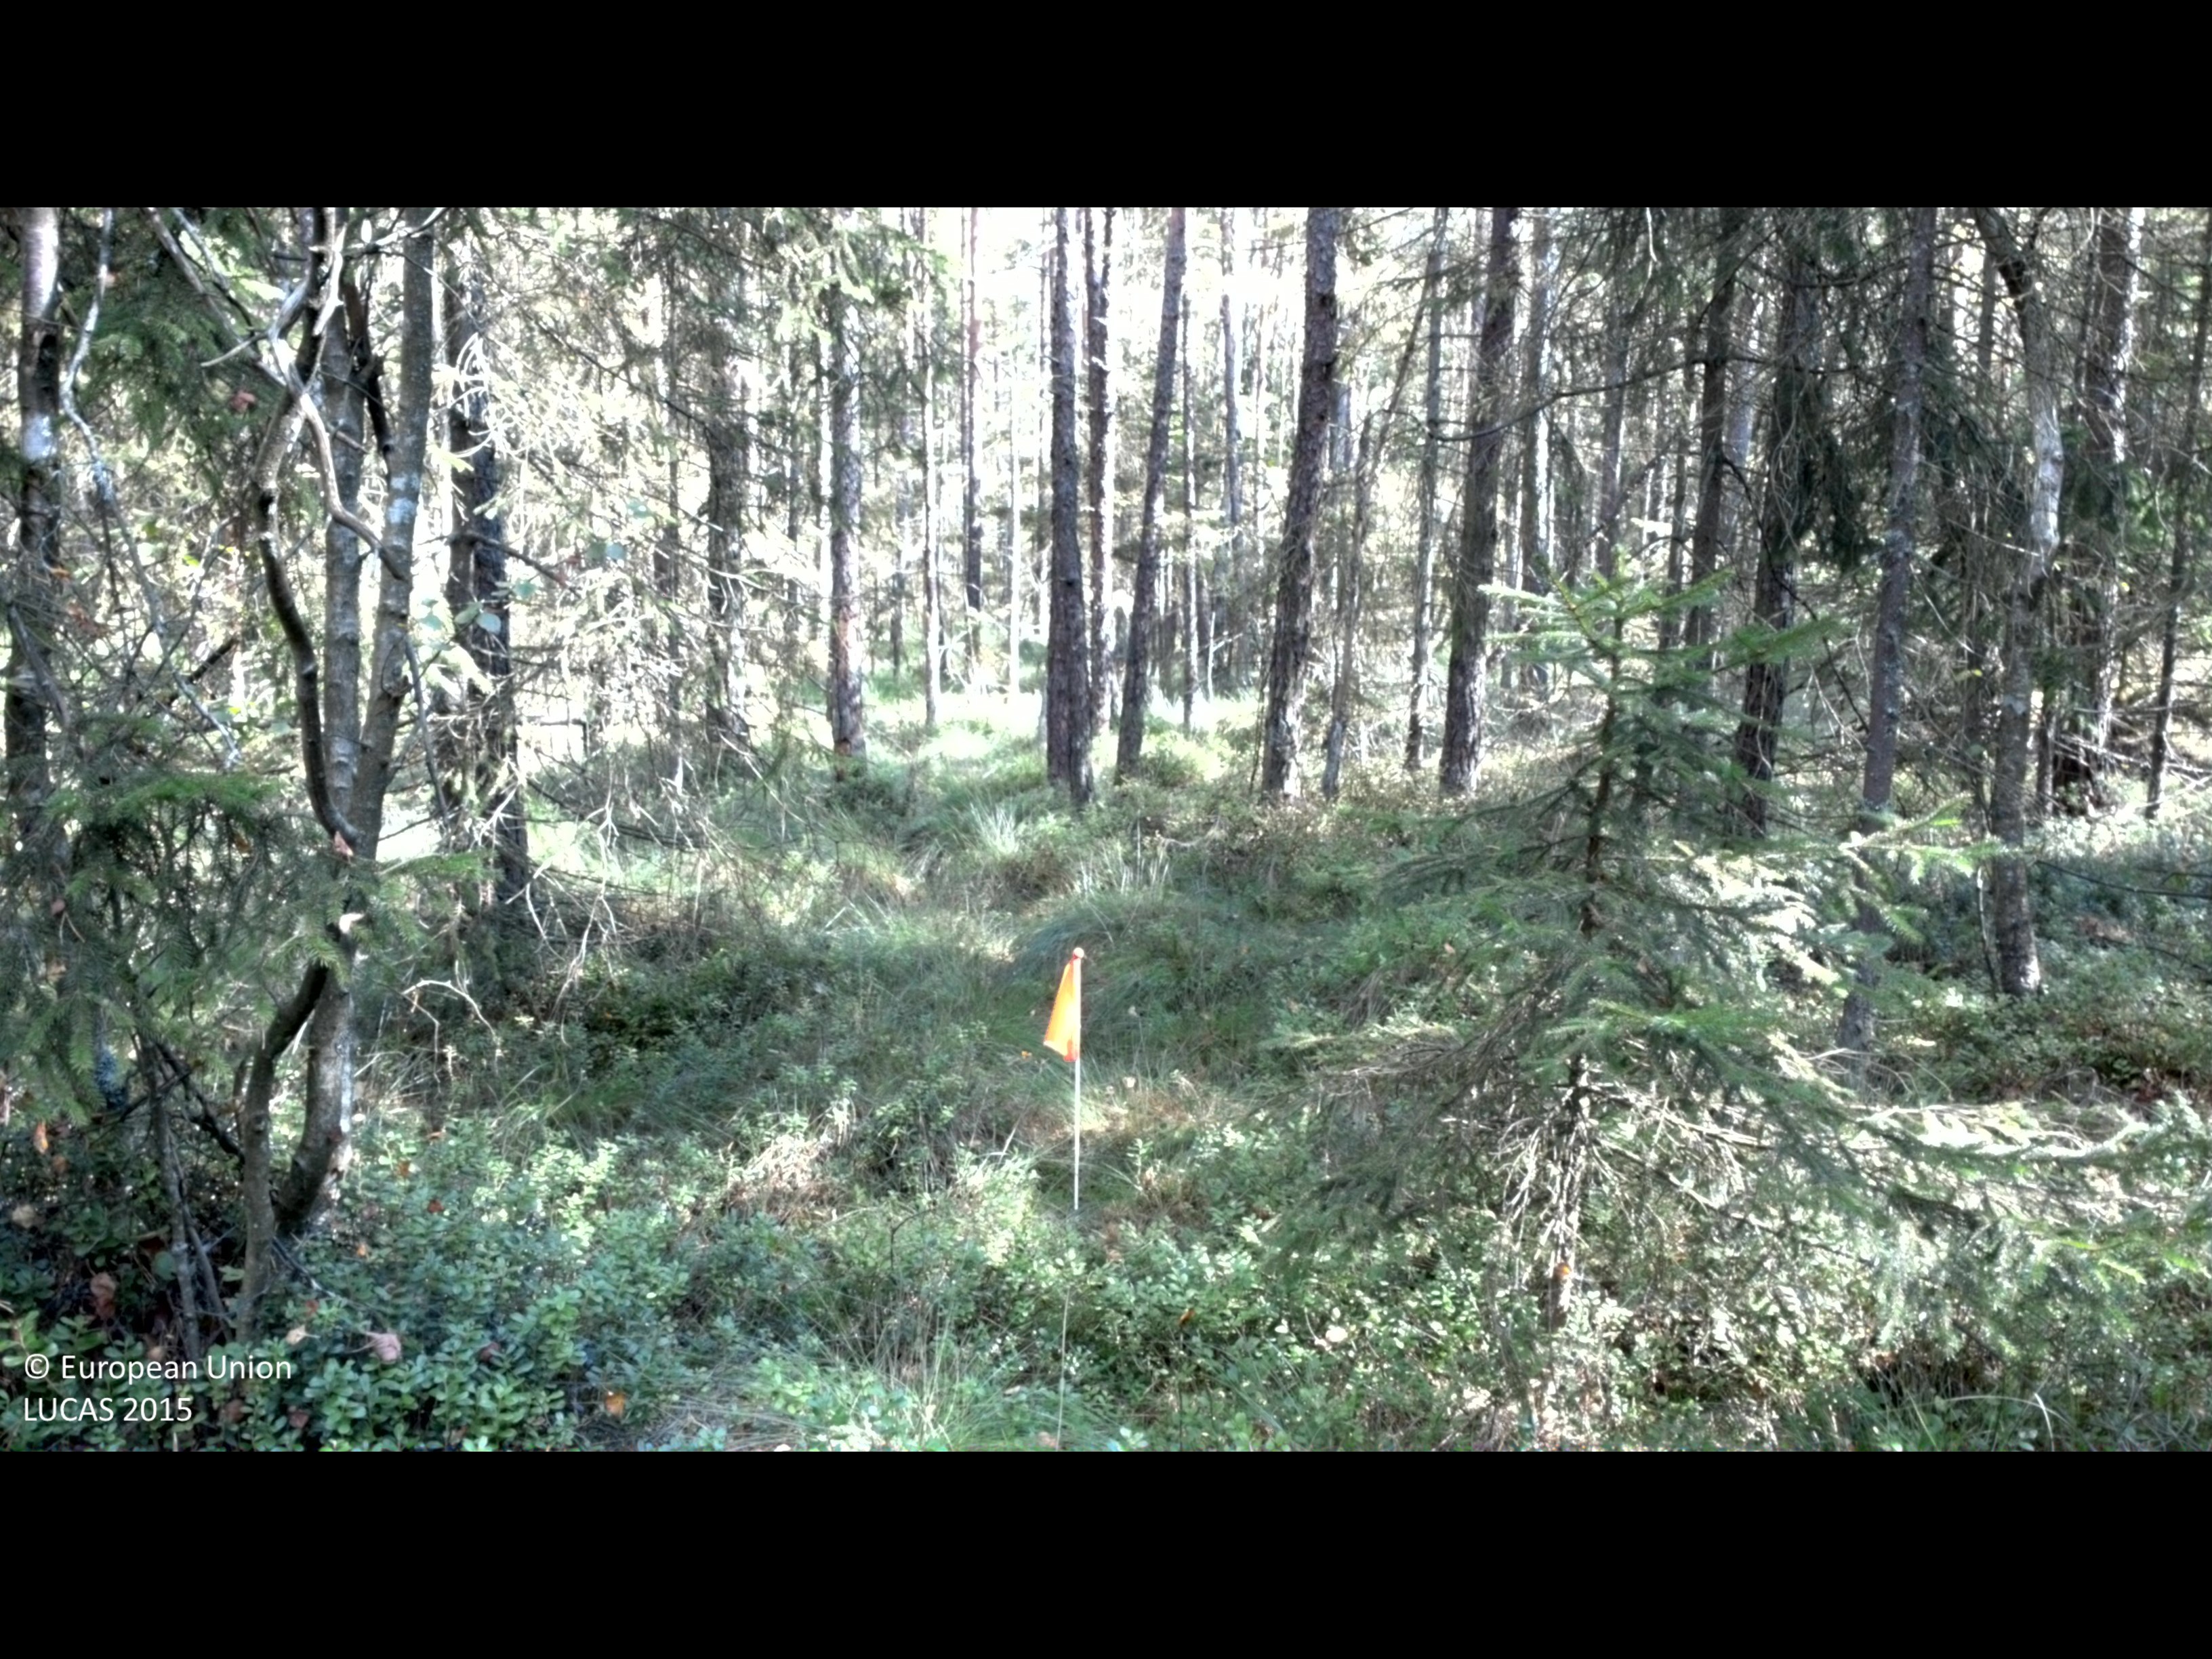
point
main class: Woodland
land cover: Pine dominated coniferous woodland
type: boreal forest
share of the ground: 50 - 75 %
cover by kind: coniferous forest trees 55 %, shrubs 30 %, broadleaved forest trees 15 %
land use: Forestry
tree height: > 5 m
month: September
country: SE
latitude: 56.7975
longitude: 13.1241
